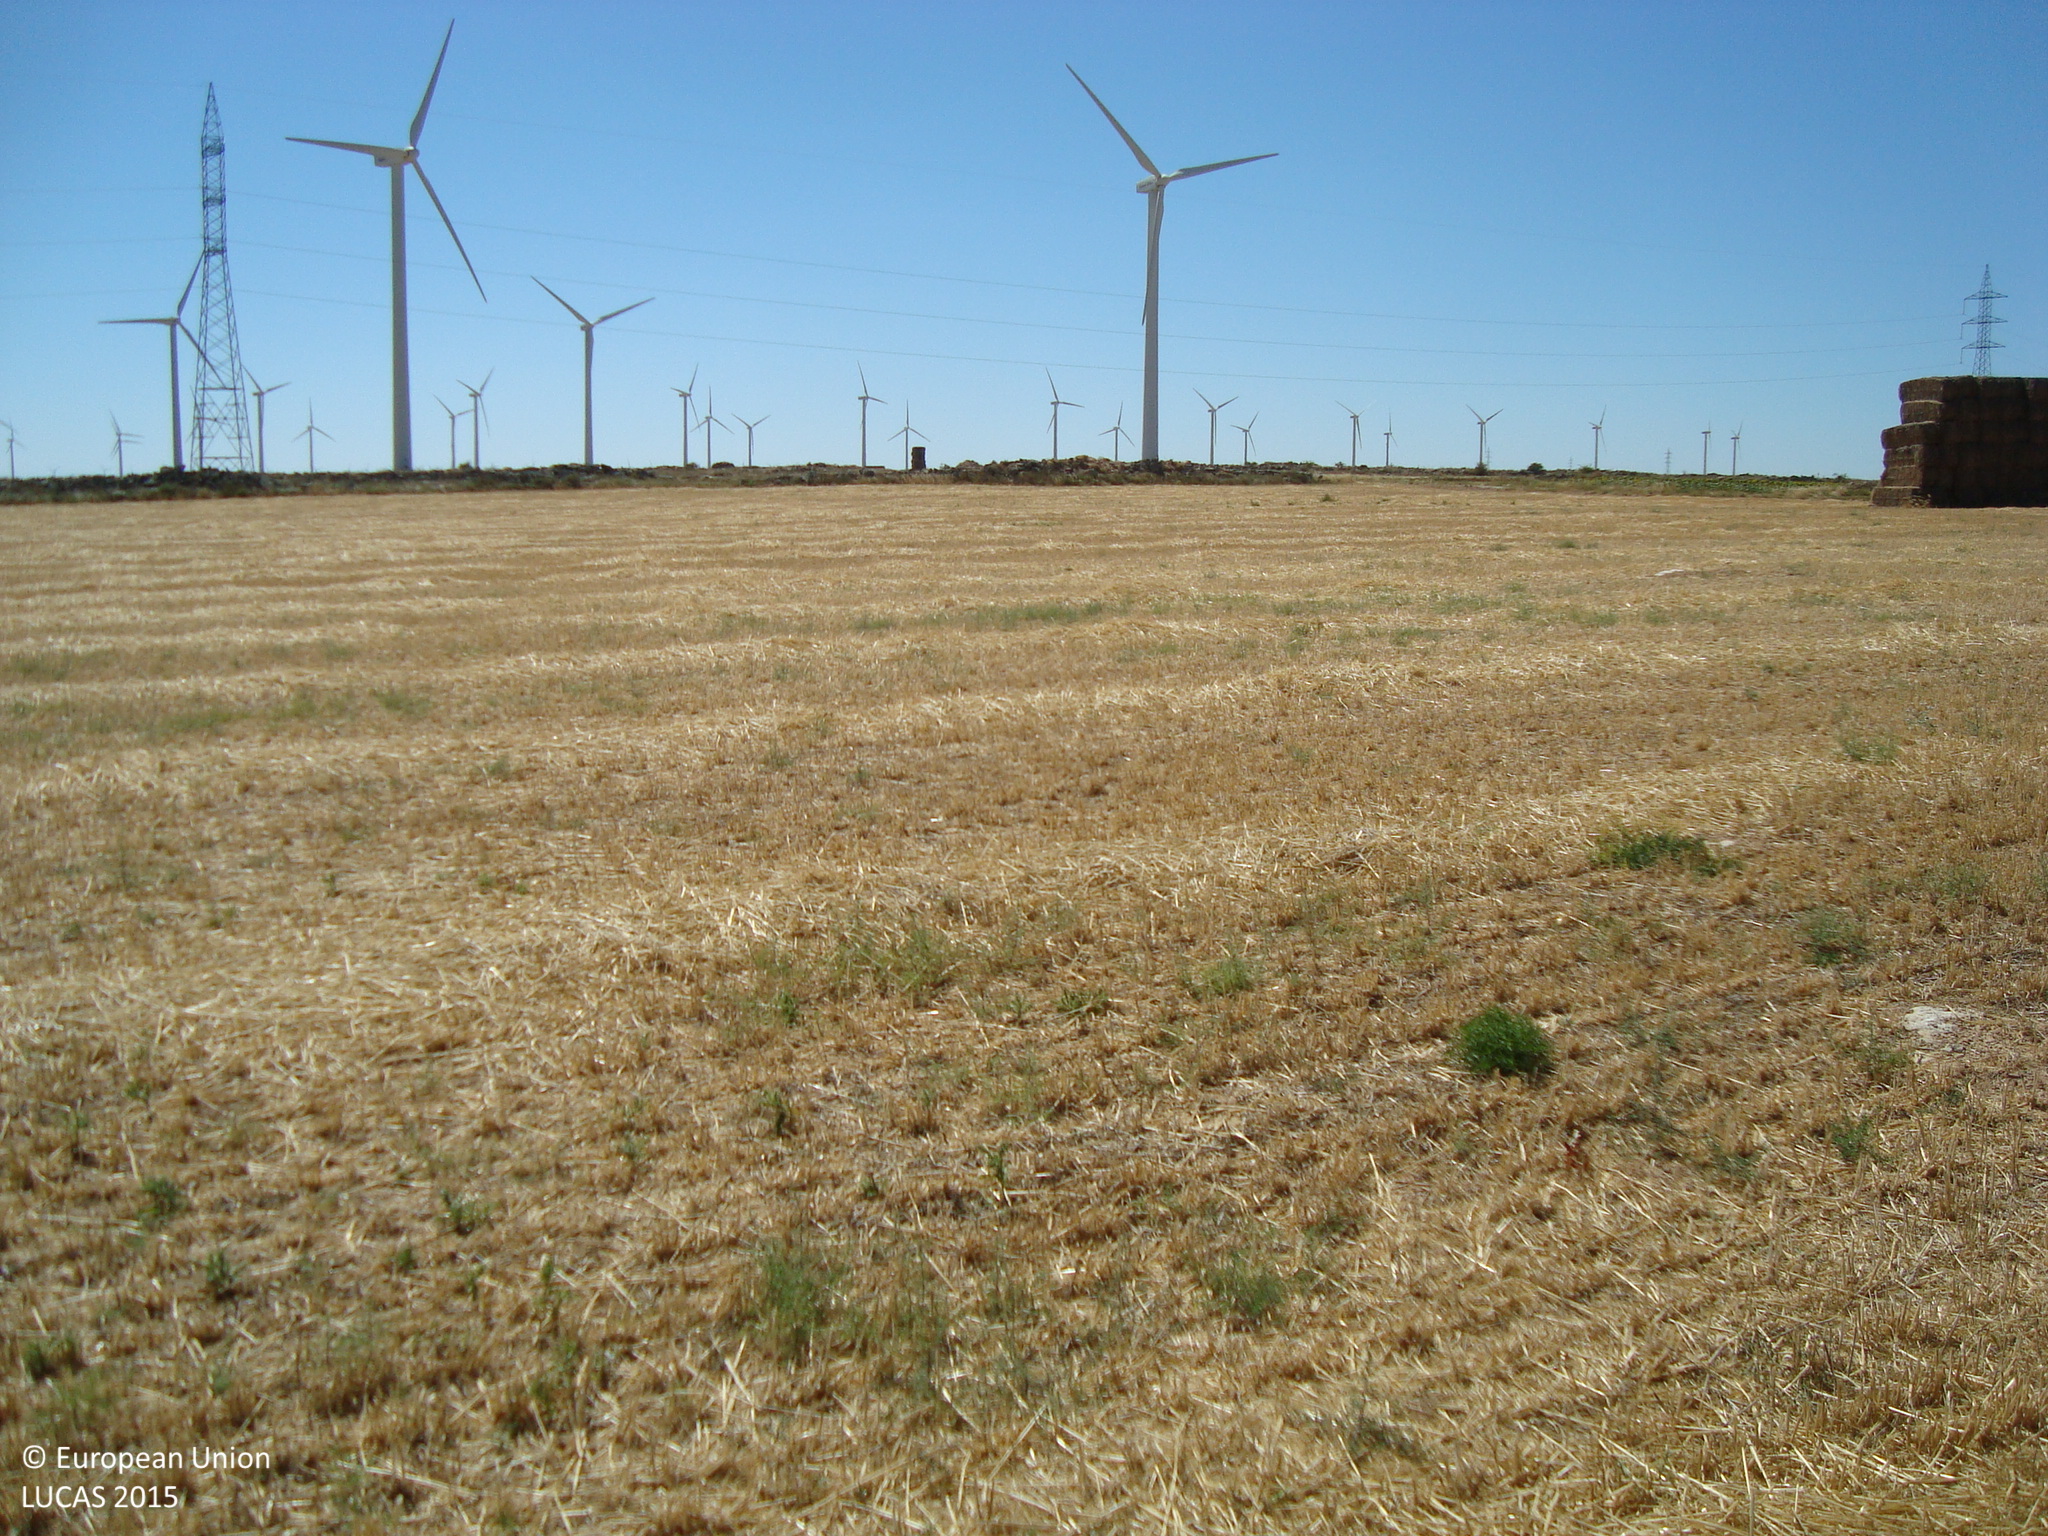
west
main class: Cropland
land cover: Barley
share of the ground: > 75 %
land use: Agriculture (excluding fallow land and kitchen gardens)
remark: Harvested field
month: August
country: ES
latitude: 42.1971
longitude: -4.1994
